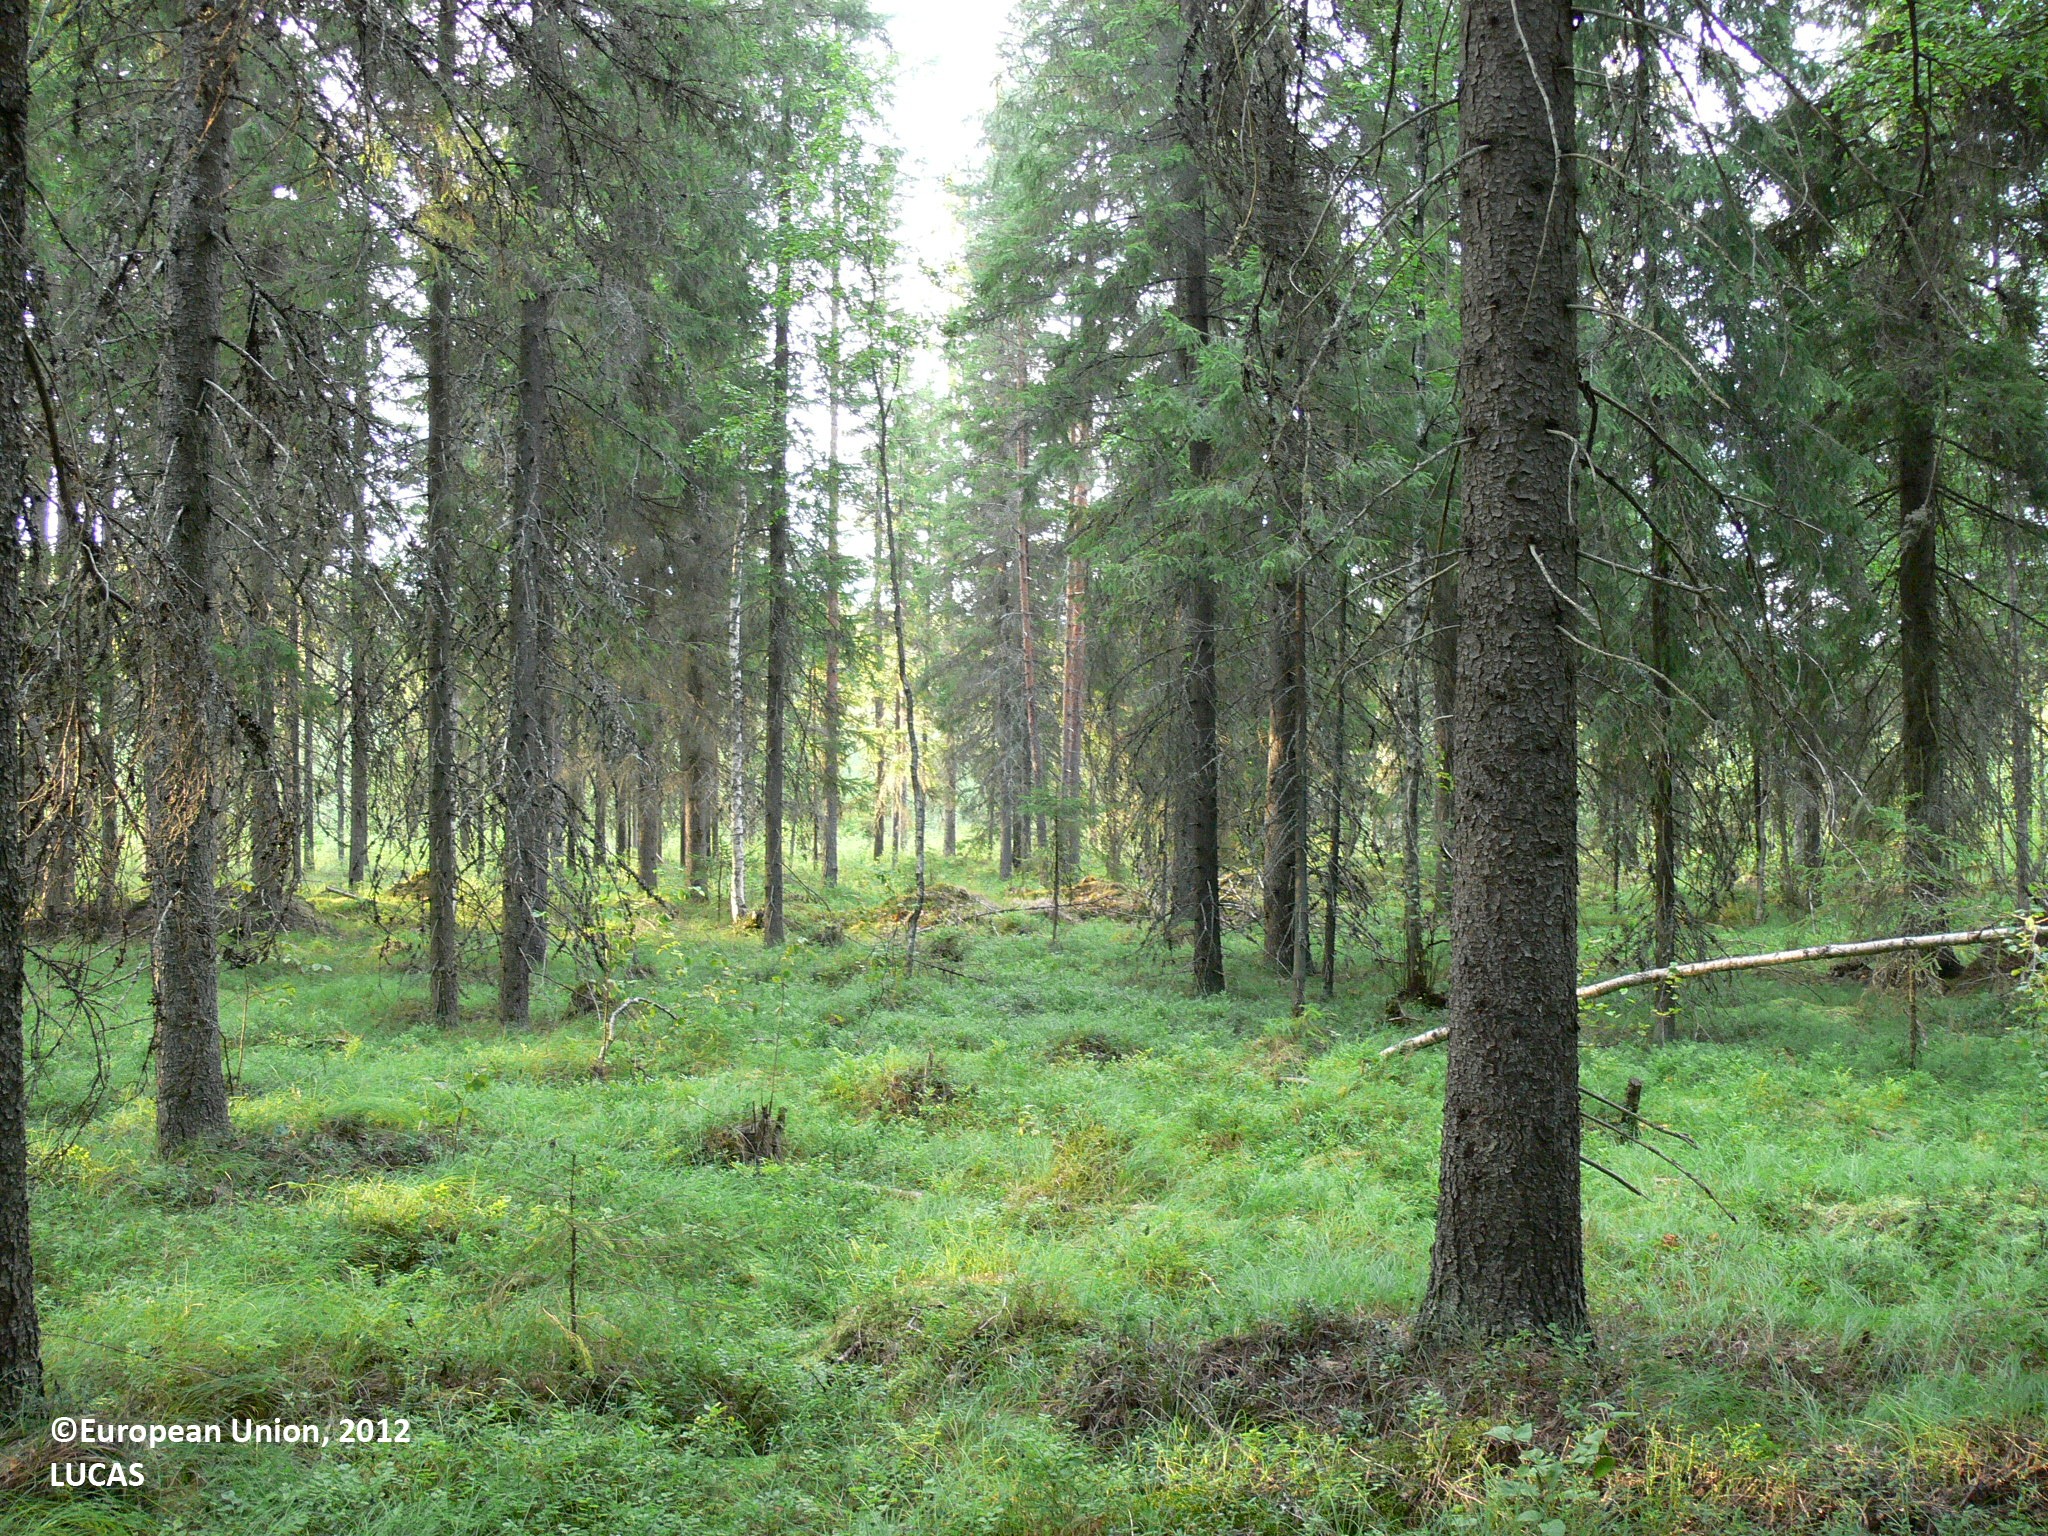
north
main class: Woodland
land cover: Spruce dominated coniferous woodland
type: boreal forest
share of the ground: > 75 %
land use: Forestry
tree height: > 5 m
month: August
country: FI
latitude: 62.1804
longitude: 30.5525
